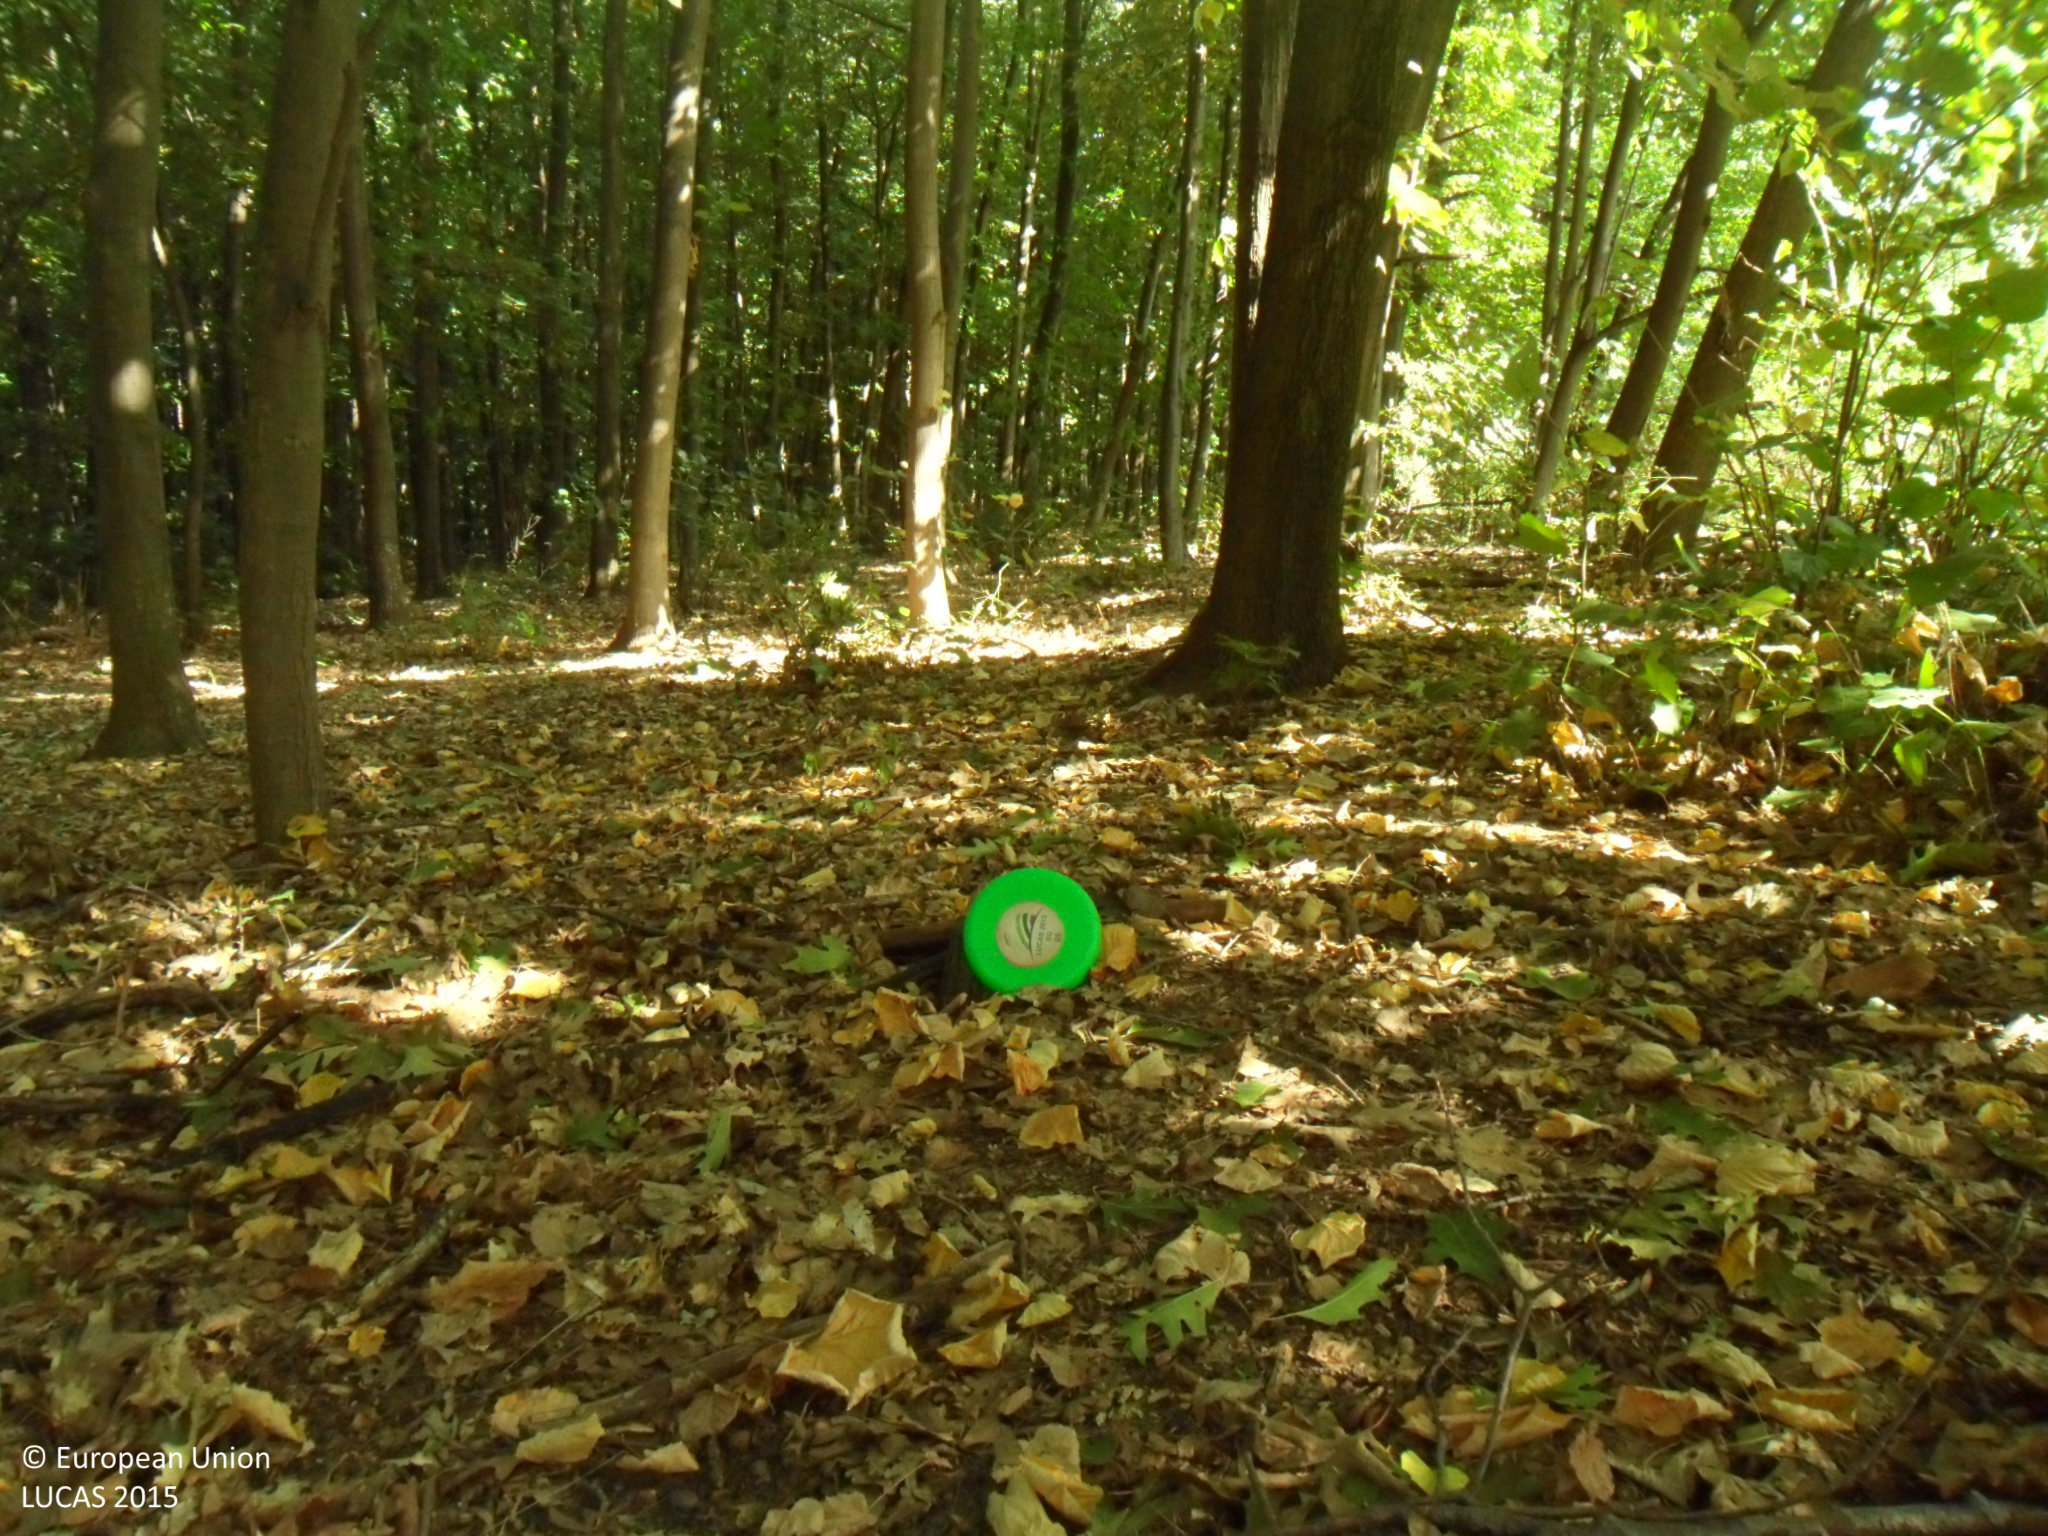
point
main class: Woodland
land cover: Broadleaved woodland
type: beech forest
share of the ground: > 75 %
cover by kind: broadleaved forest trees 95 %, unconsolidated bare surface 5 %
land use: Forestry
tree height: > 5 m
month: September
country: BG
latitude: 43.9117
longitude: 26.4328
